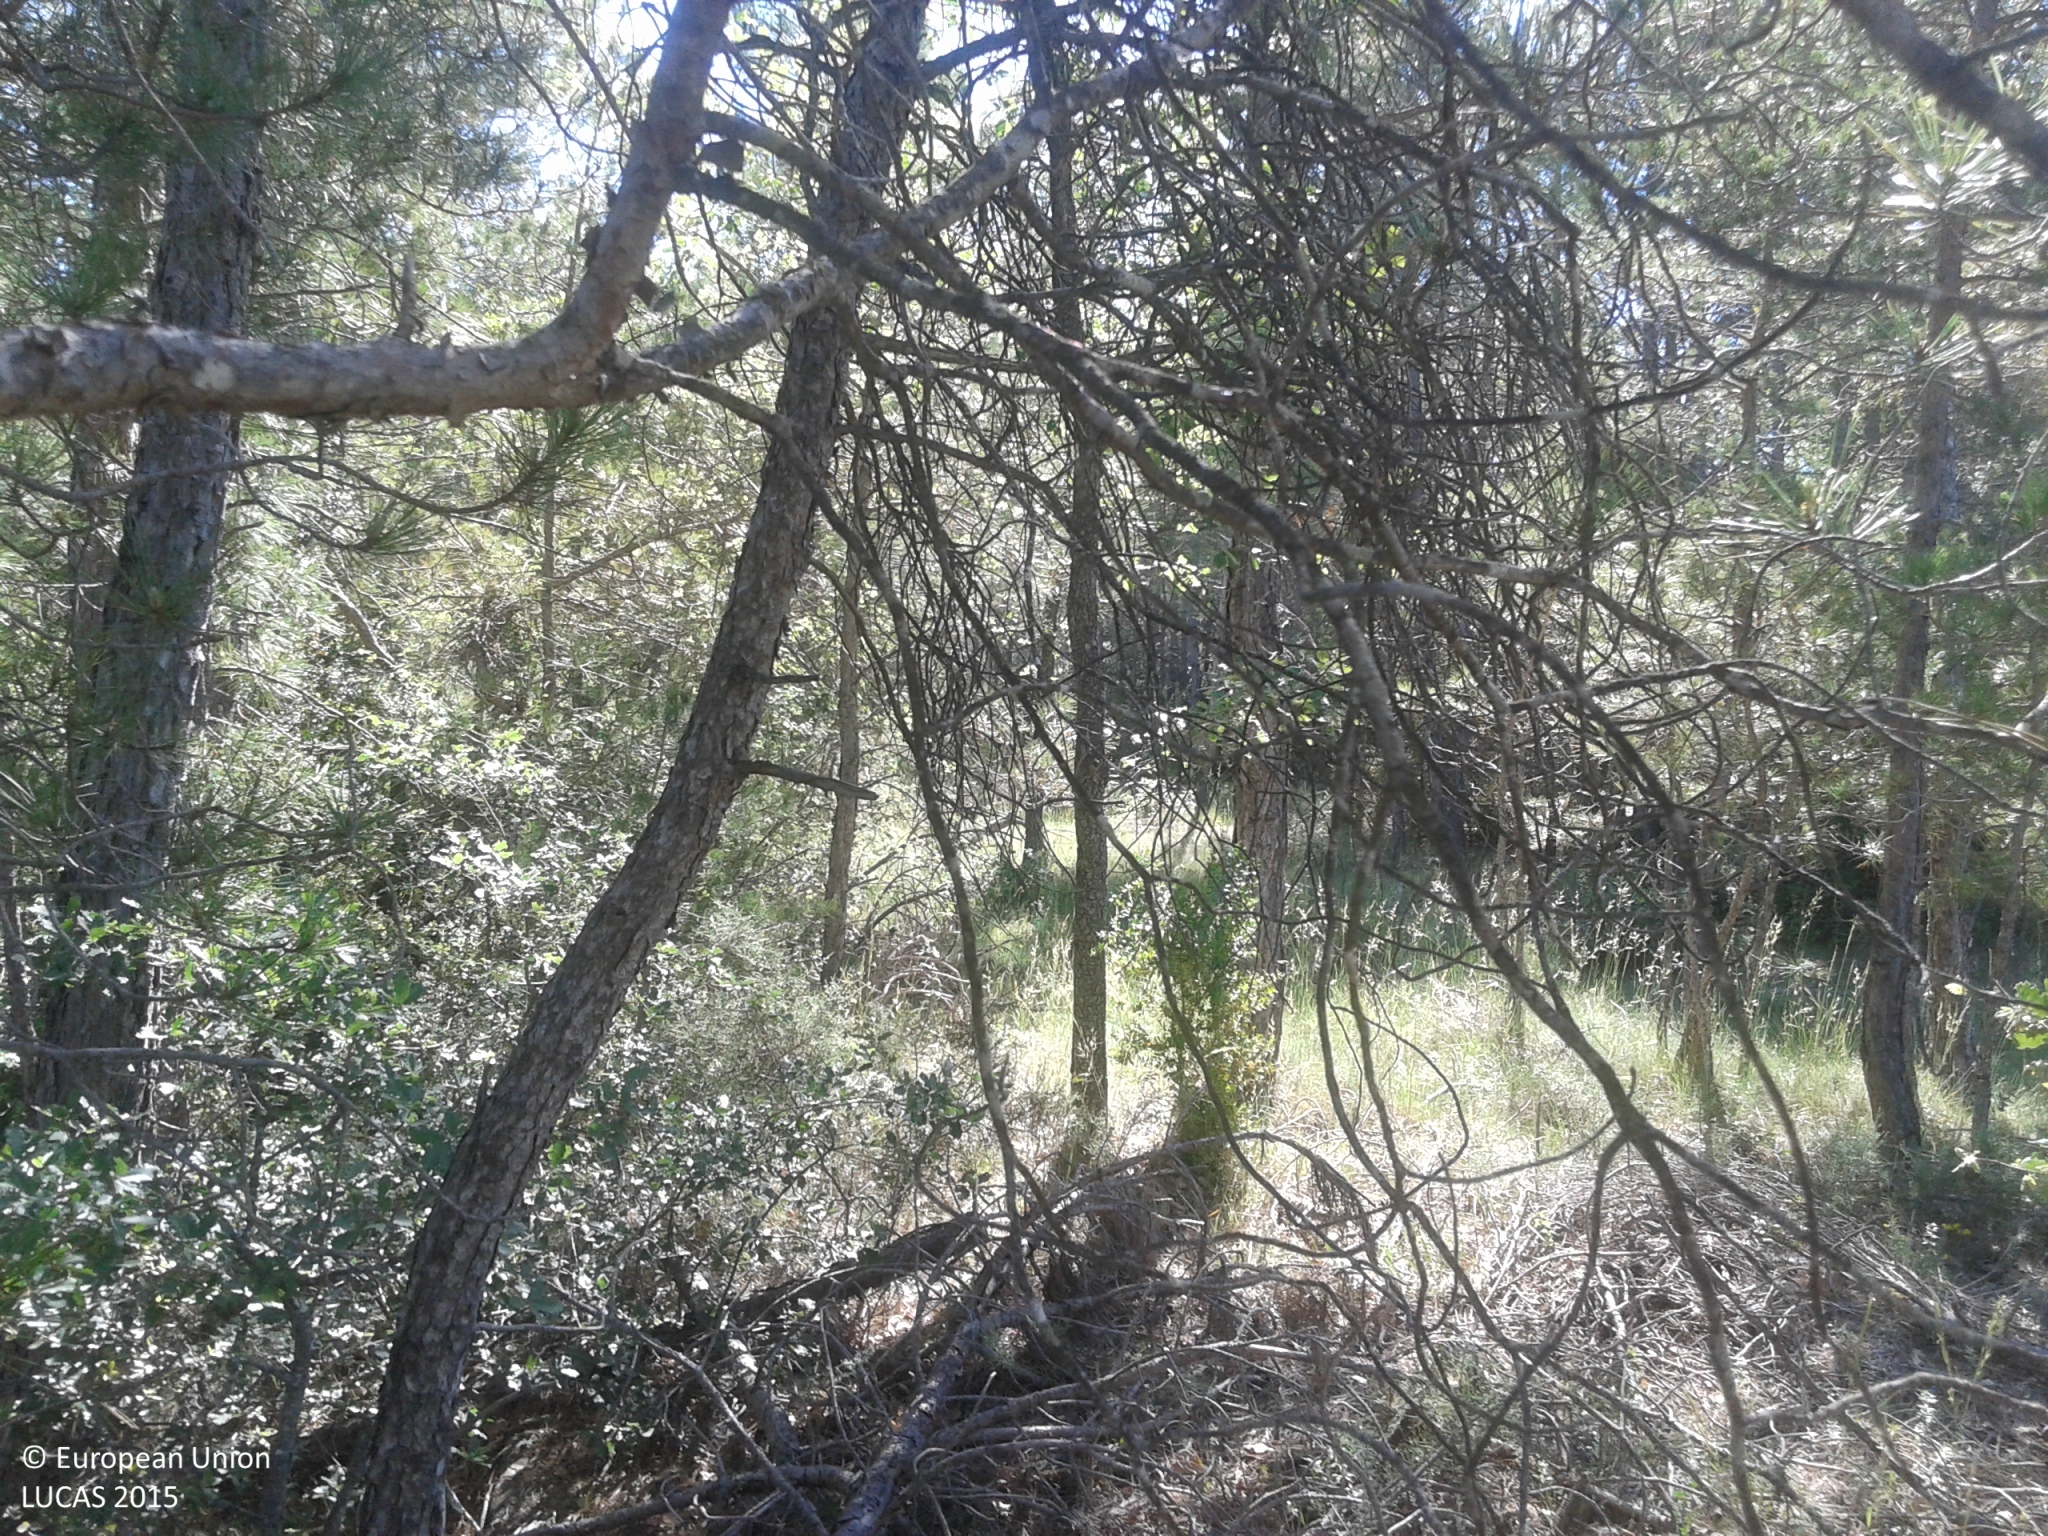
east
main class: Woodland
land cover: Pine dominated coniferous woodland
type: coniferous forest of the mediterranean region
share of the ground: > 75 %
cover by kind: coniferous forest trees 75 %, shrubs 15 %, broadleaved forest trees 10 %
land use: Forestry
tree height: > 5 m
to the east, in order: Pine dominated coniferous woodland; Tracks; Pine dominated coniferous woodland; Tracks; Pine dominated mixed woodland; Tracks; Pine dominated mixed woodland
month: May
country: ES
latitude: 42.0139
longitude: 1.5961
